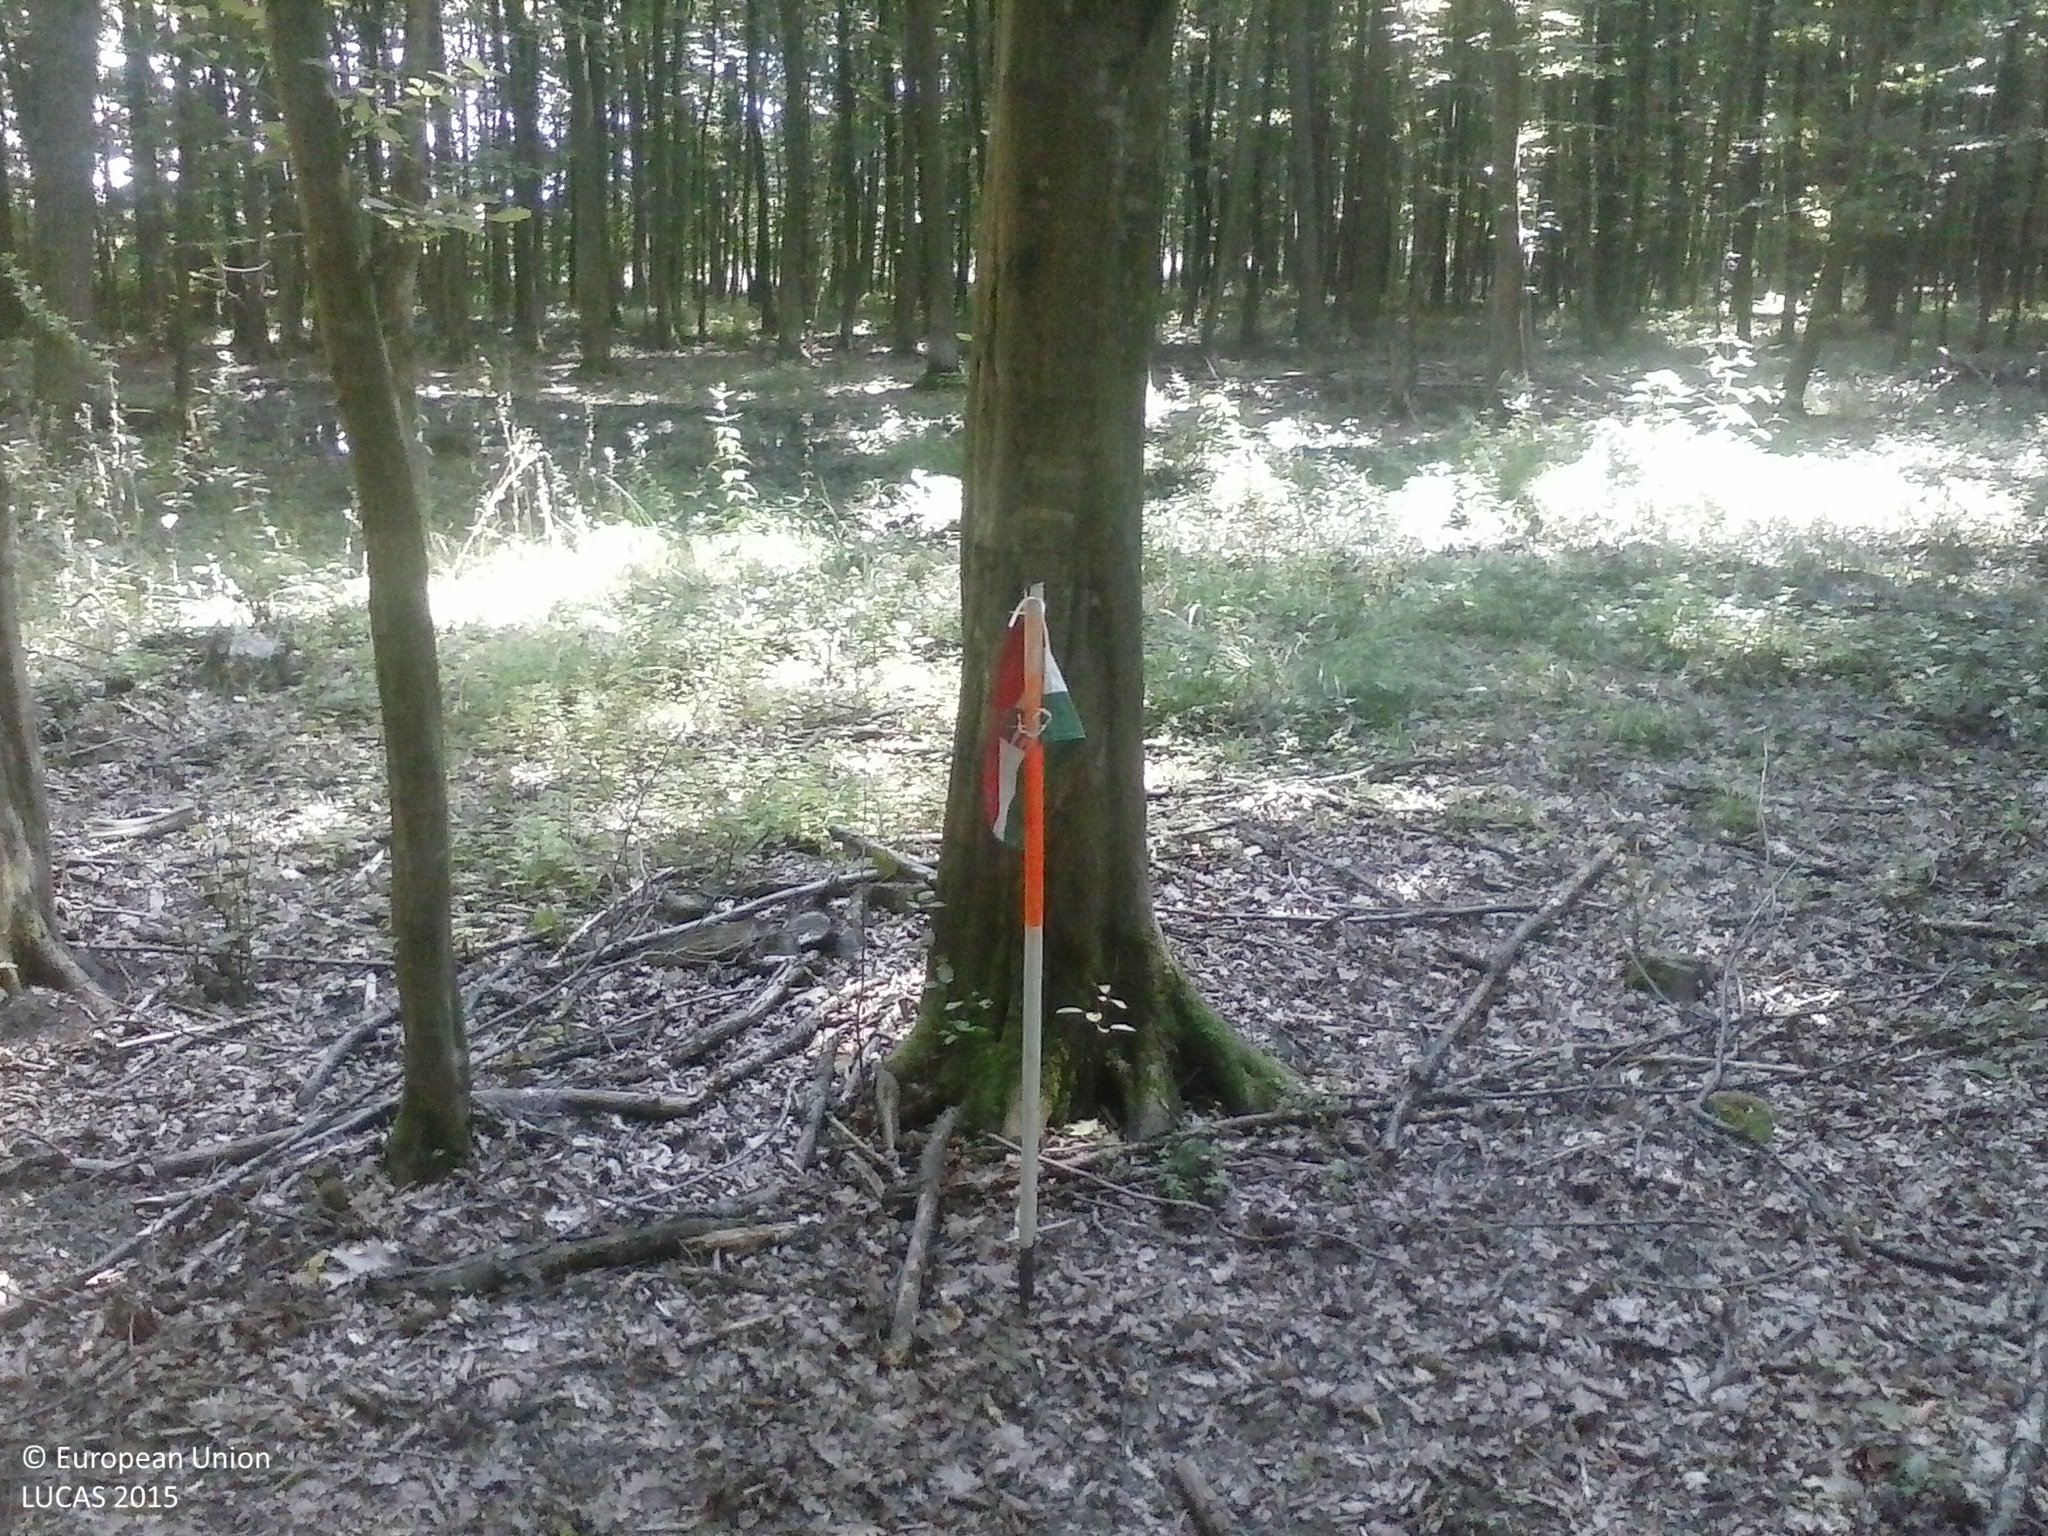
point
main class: Woodland
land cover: Broadleaved woodland
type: mesophytic deciduous forest
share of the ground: > 75 %
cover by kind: broadleaved forest trees 90 %, shrubs 5 %, consolidated bare surface 5 %
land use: Forestry
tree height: > 5 m
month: August
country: HU
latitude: 45.8747
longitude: 17.6951
